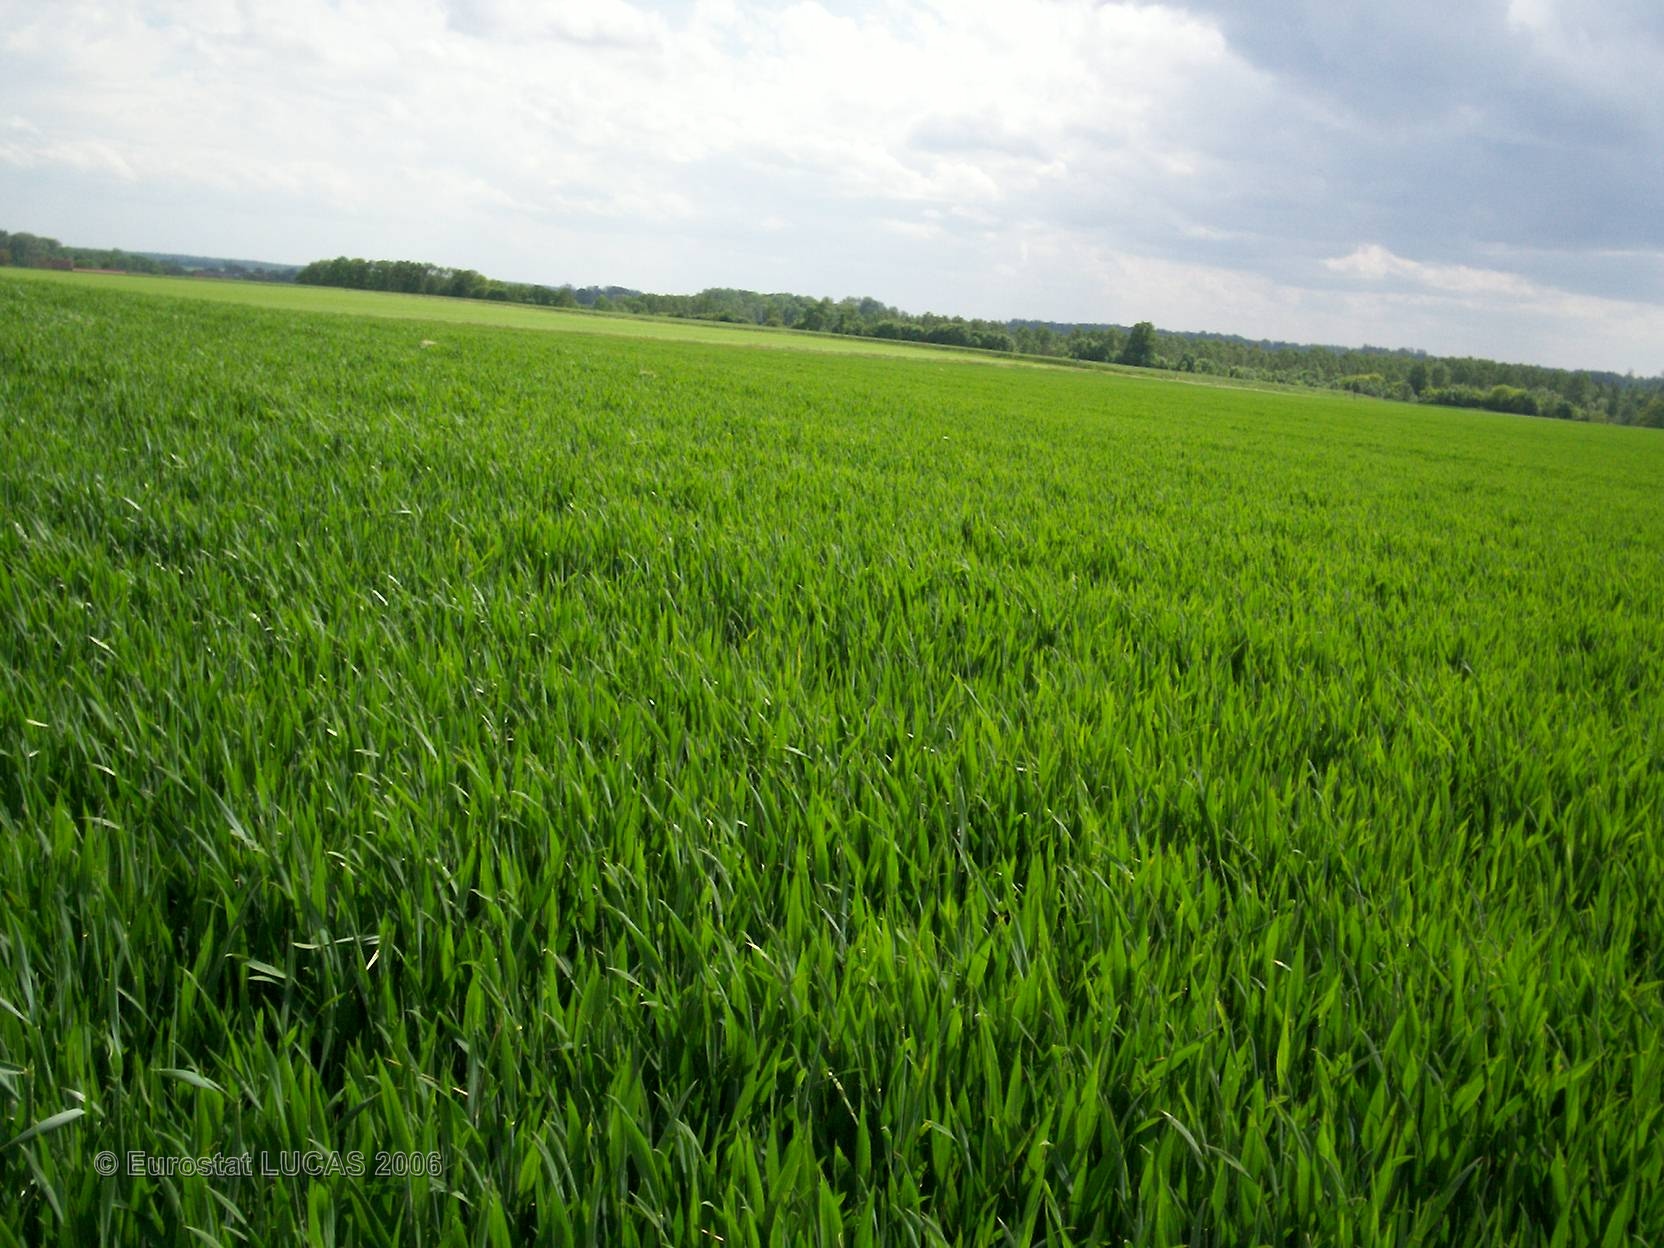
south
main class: Cropland
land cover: Common wheat
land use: Agriculture (excluding fallow land and kitchen gardens)
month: May
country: FR
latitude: 48.3916
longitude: 4.4738
